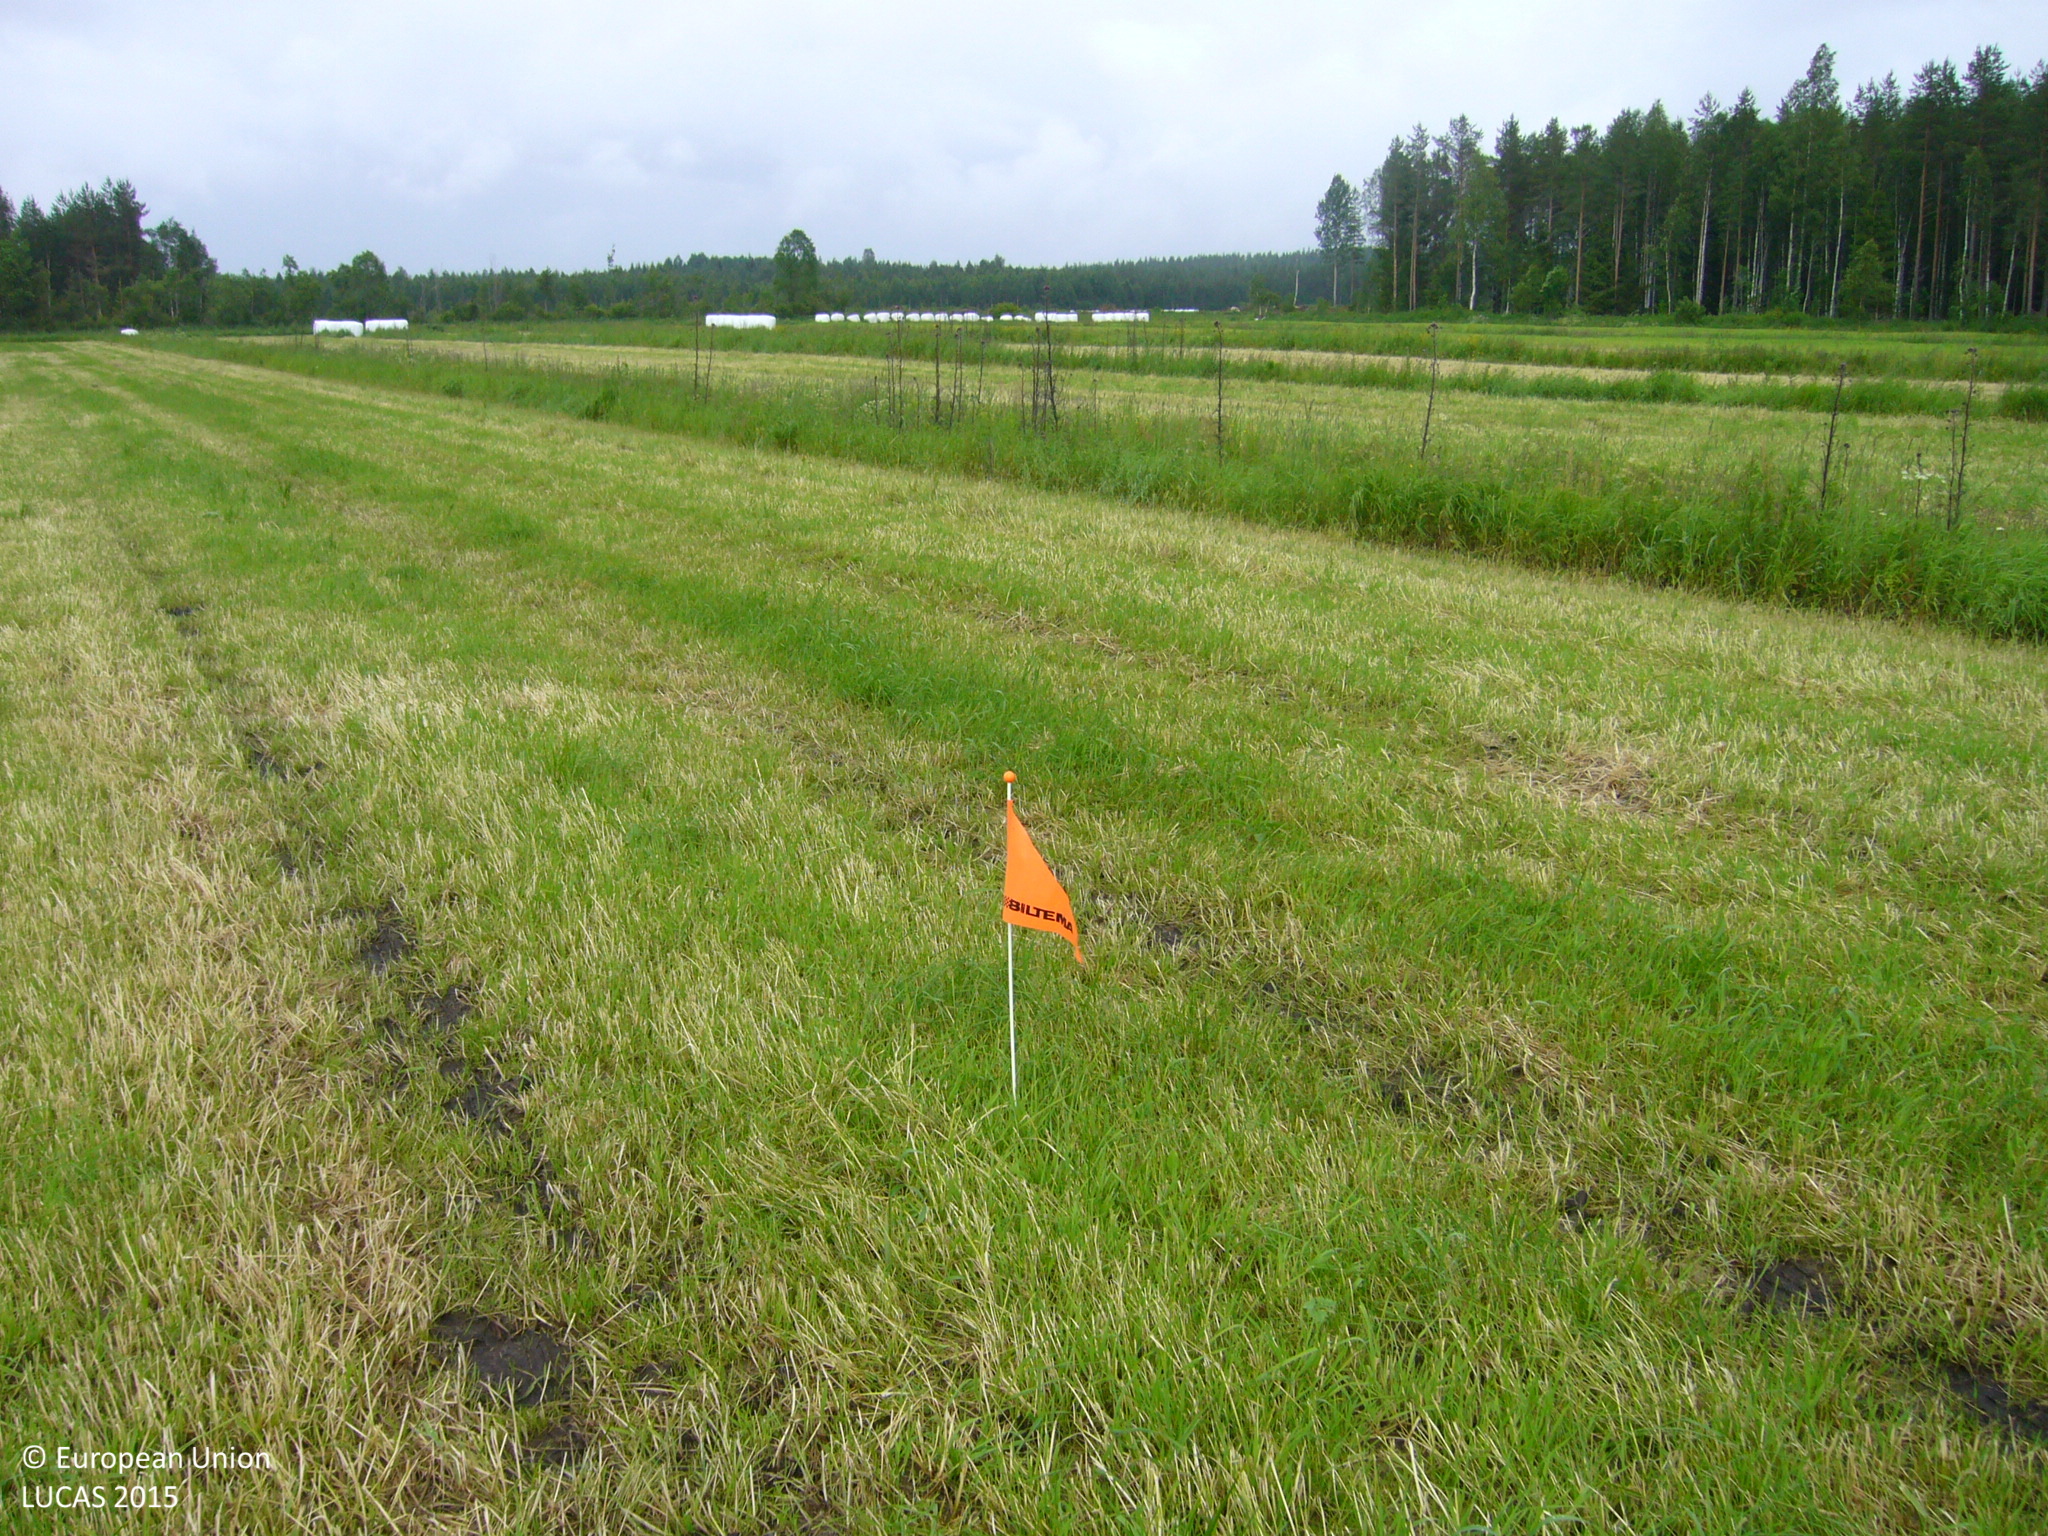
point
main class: Cropland
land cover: Temporary grasslands
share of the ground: > 75 %
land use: Agriculture (excluding fallow land and kitchen gardens)
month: July
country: FI
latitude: 63.6125
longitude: 25.4874
